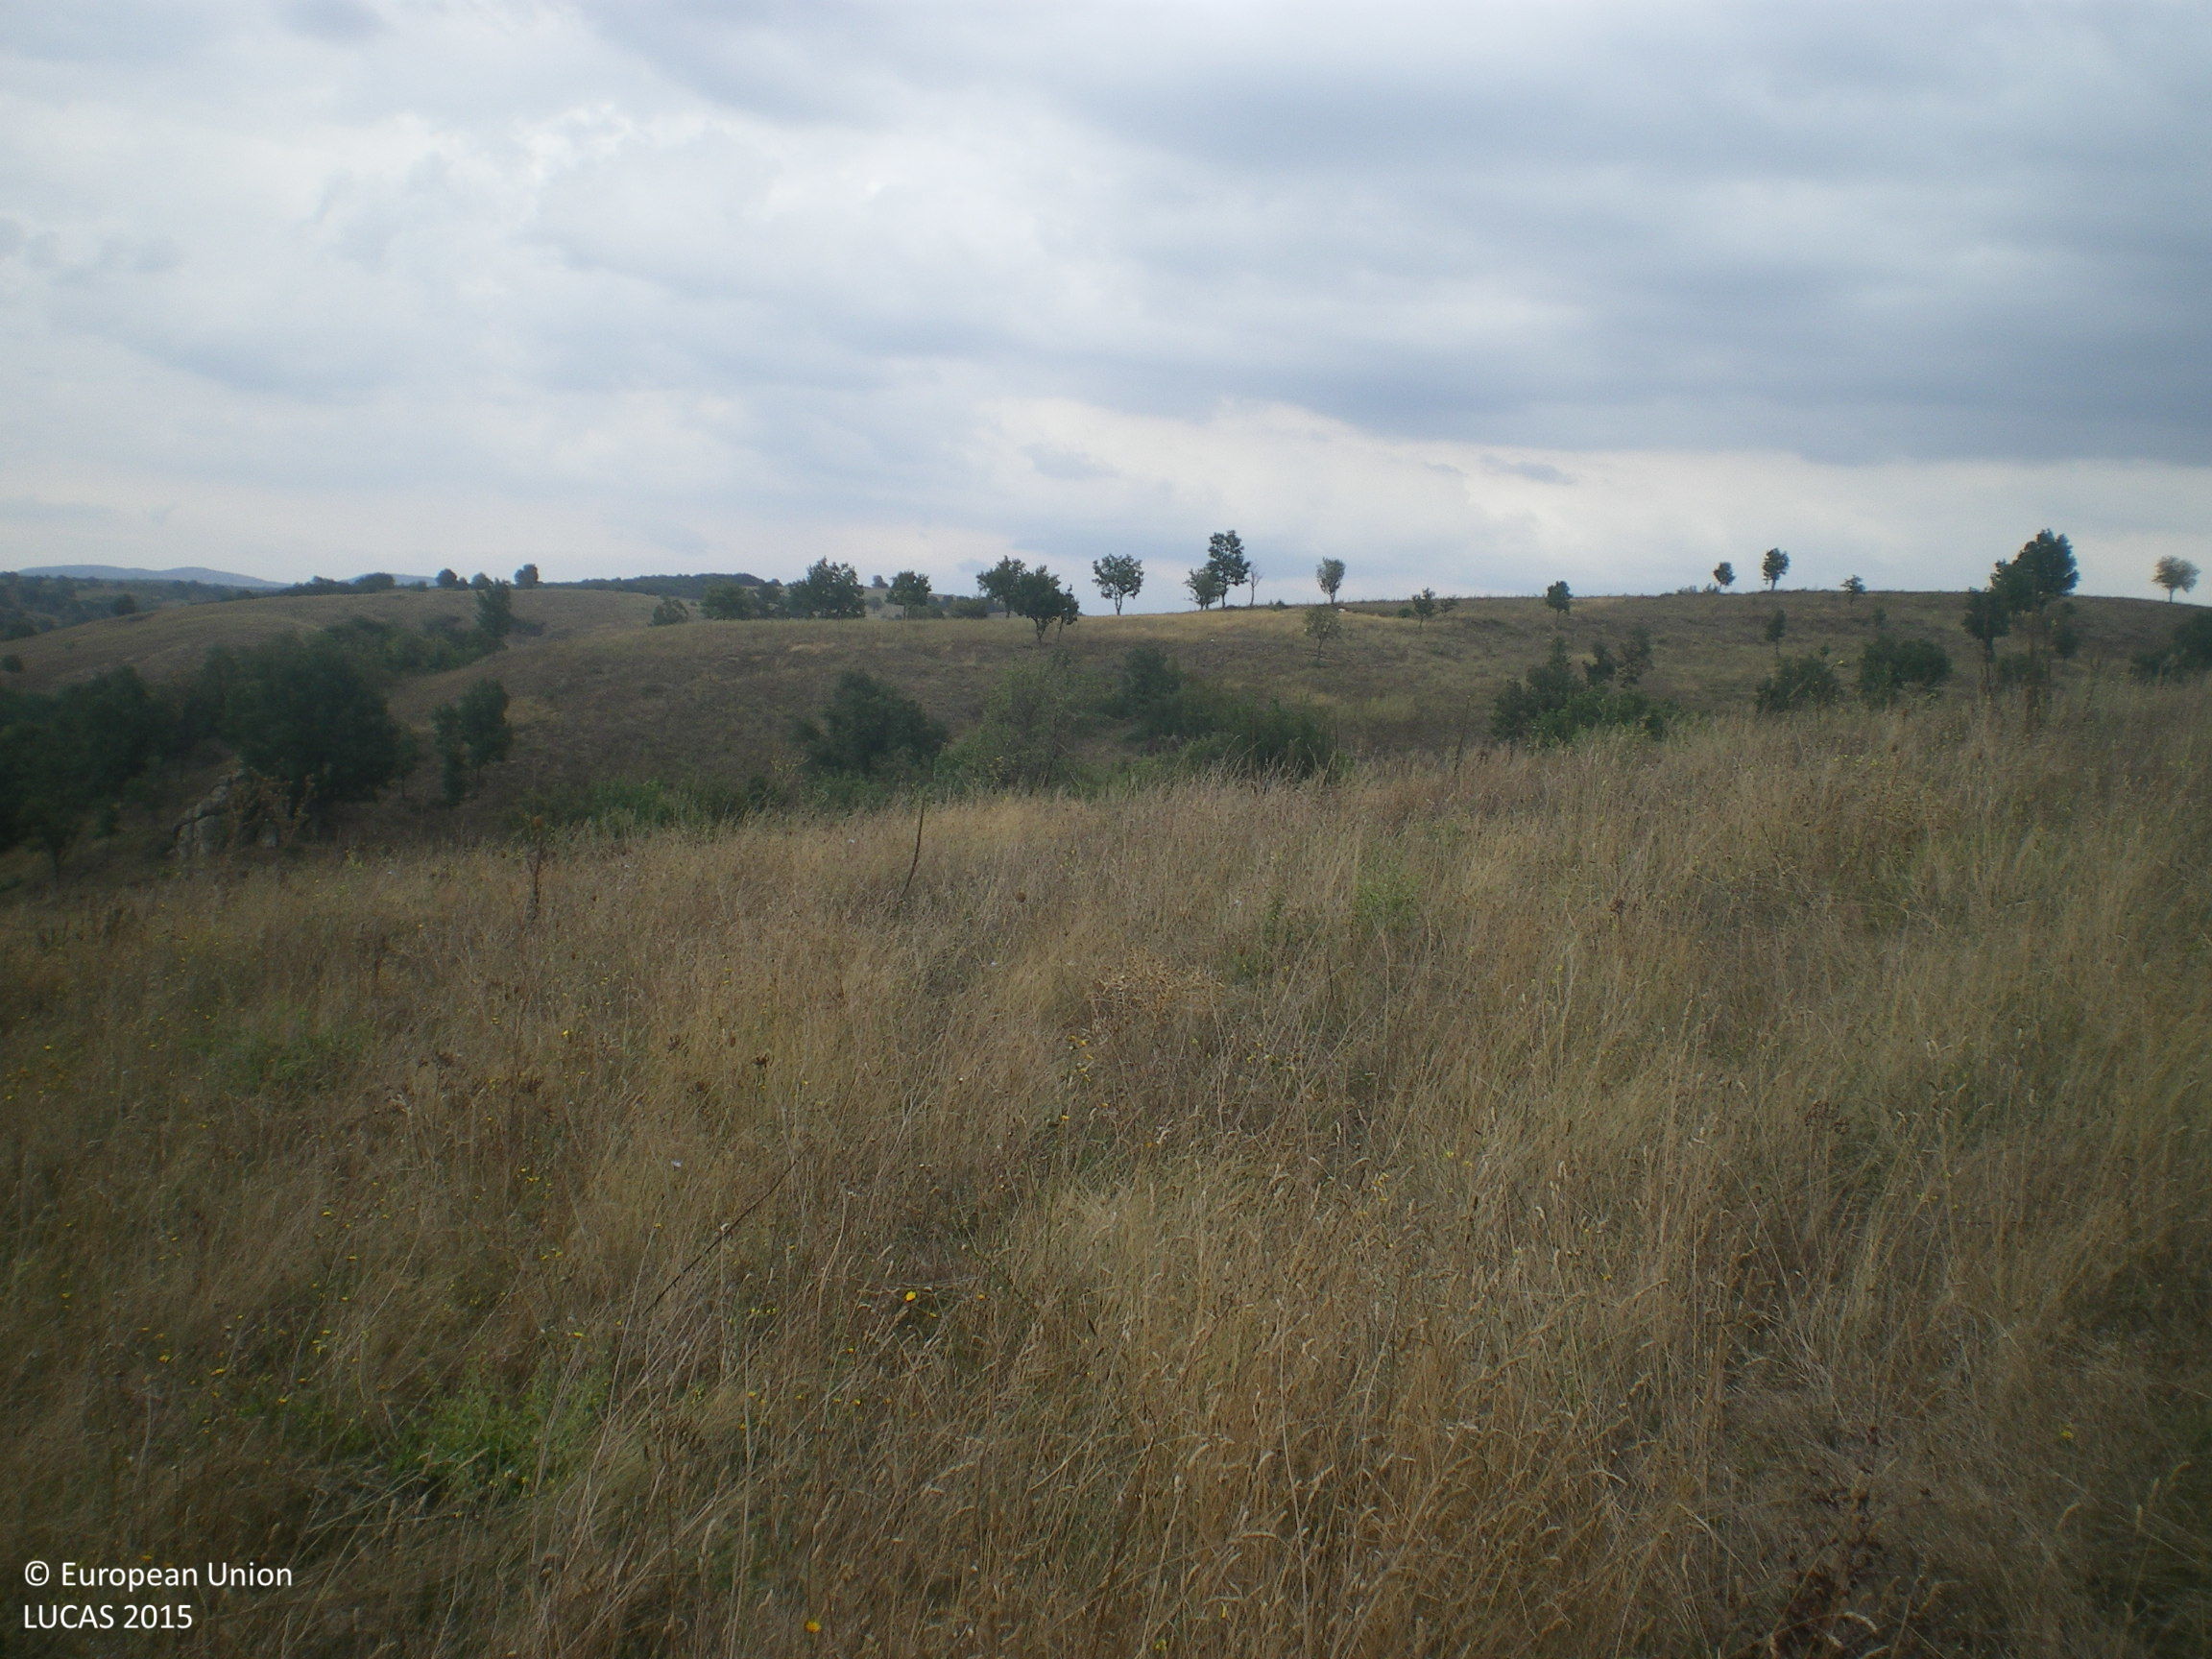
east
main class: Grassland
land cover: Grassland with sparse tree/shrub cover
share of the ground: > 75 %
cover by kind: herbaceous plants 90 %, broadleaved forest trees 5 %, shrubs 5 %
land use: Semi-natural and natural areas not in use
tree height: > 5 m
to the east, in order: Grassland with sparse tree/shrub cover; Broadleaved woodland; Rivers and streams; Broadleaved woodland; Grassland with sparse tree/shrub cover; Broadleaved woodland; Rivers and streams; Broadleaved woodland; Grassland with sparse tree/shrub cover; Grassland without tree/shrub cover; Grassland with sparse tree/shrub cover
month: September
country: BG
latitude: 42.0190
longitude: 25.9788
